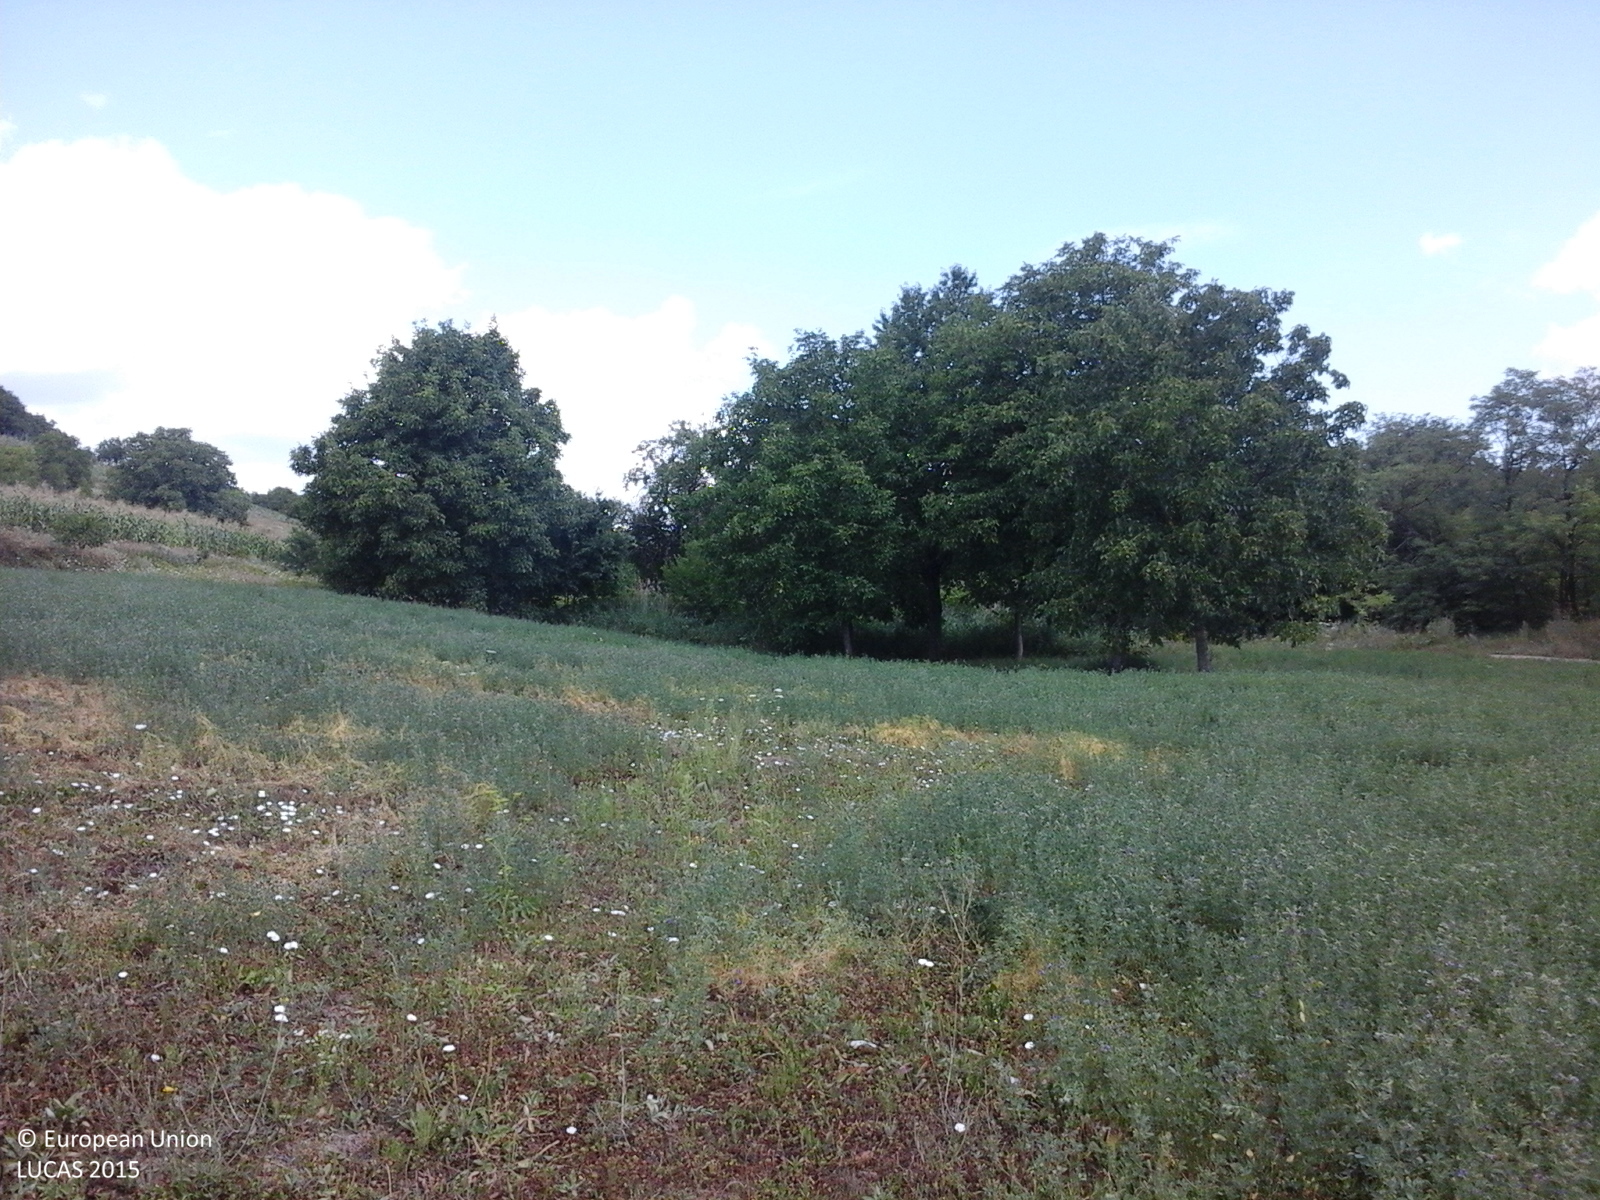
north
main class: Cropland
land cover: Lucerne
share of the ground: > 75 %
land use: Agriculture (excluding fallow land and kitchen gardens)
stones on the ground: < 10 %
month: July
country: RO
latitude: 46.5761
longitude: 27.2360
